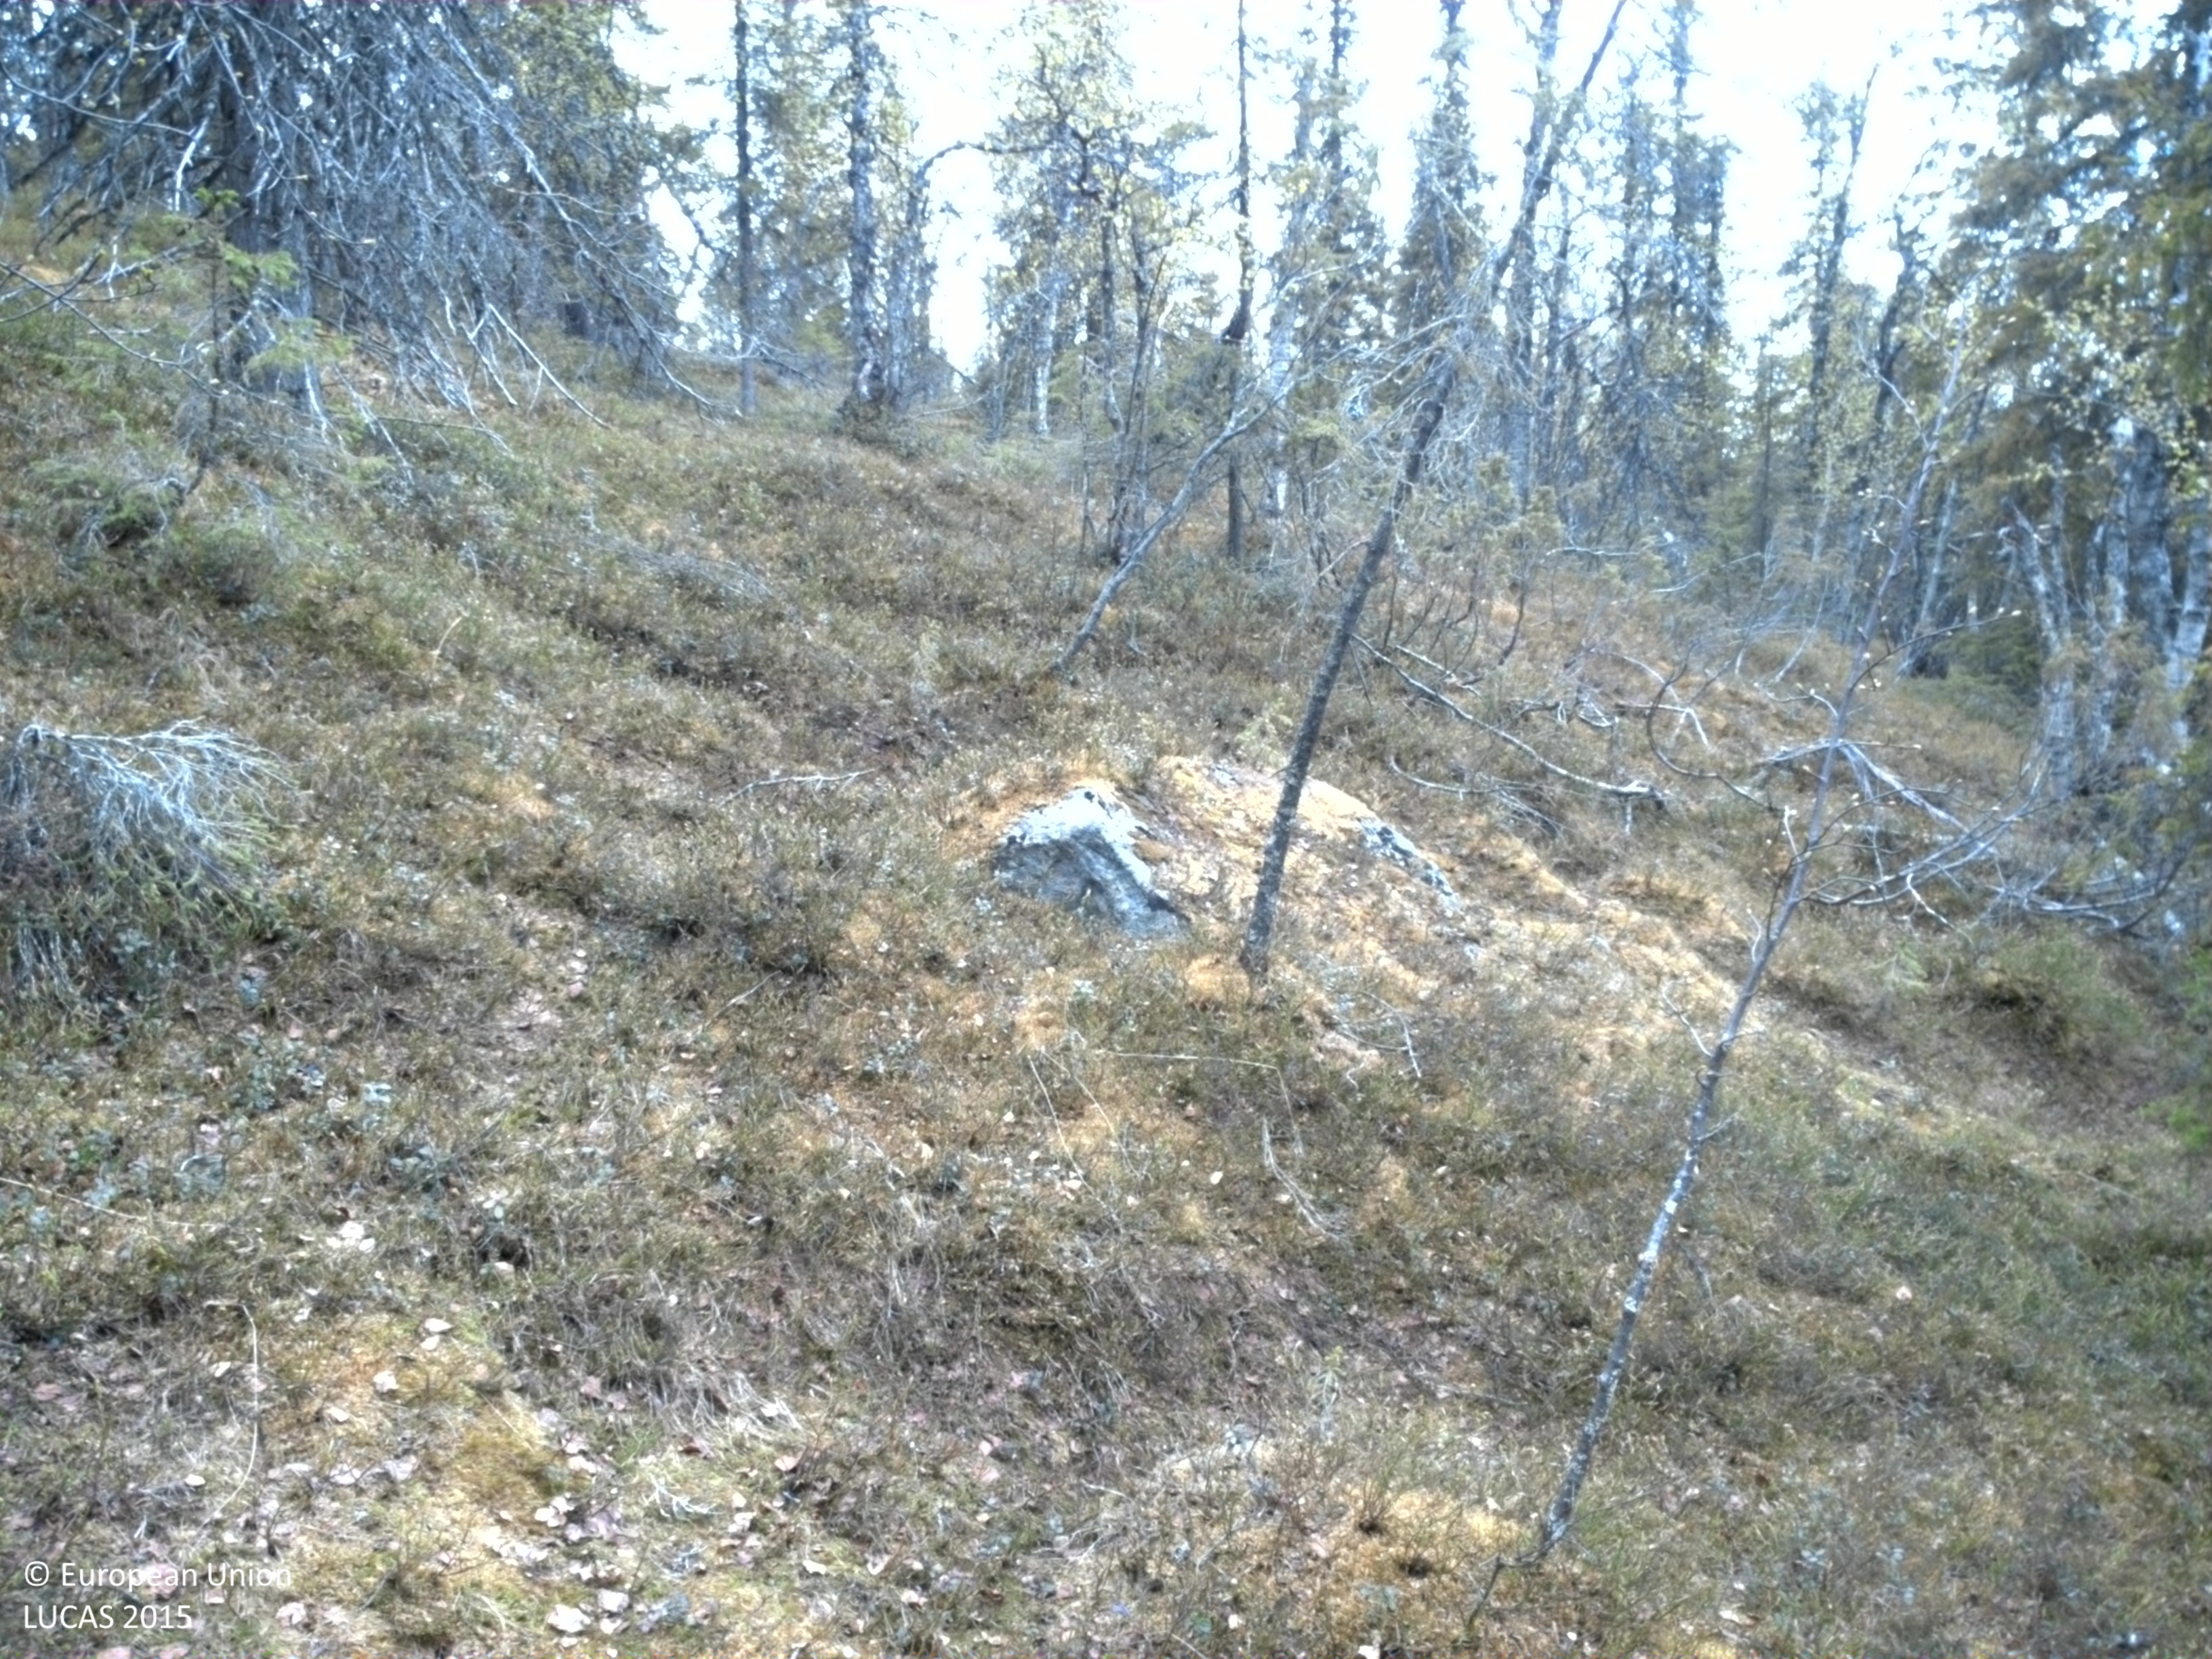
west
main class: Woodland
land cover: Spruce dominated mixed woodland
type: boreal forest
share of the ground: 50 - 75 %
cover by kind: coniferous forest trees 40 %, shrubs 35 %, broadleaved forest trees 25 %
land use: Forestry
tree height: > 5 m
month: June
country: SE
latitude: 66.1851
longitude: 18.9431
